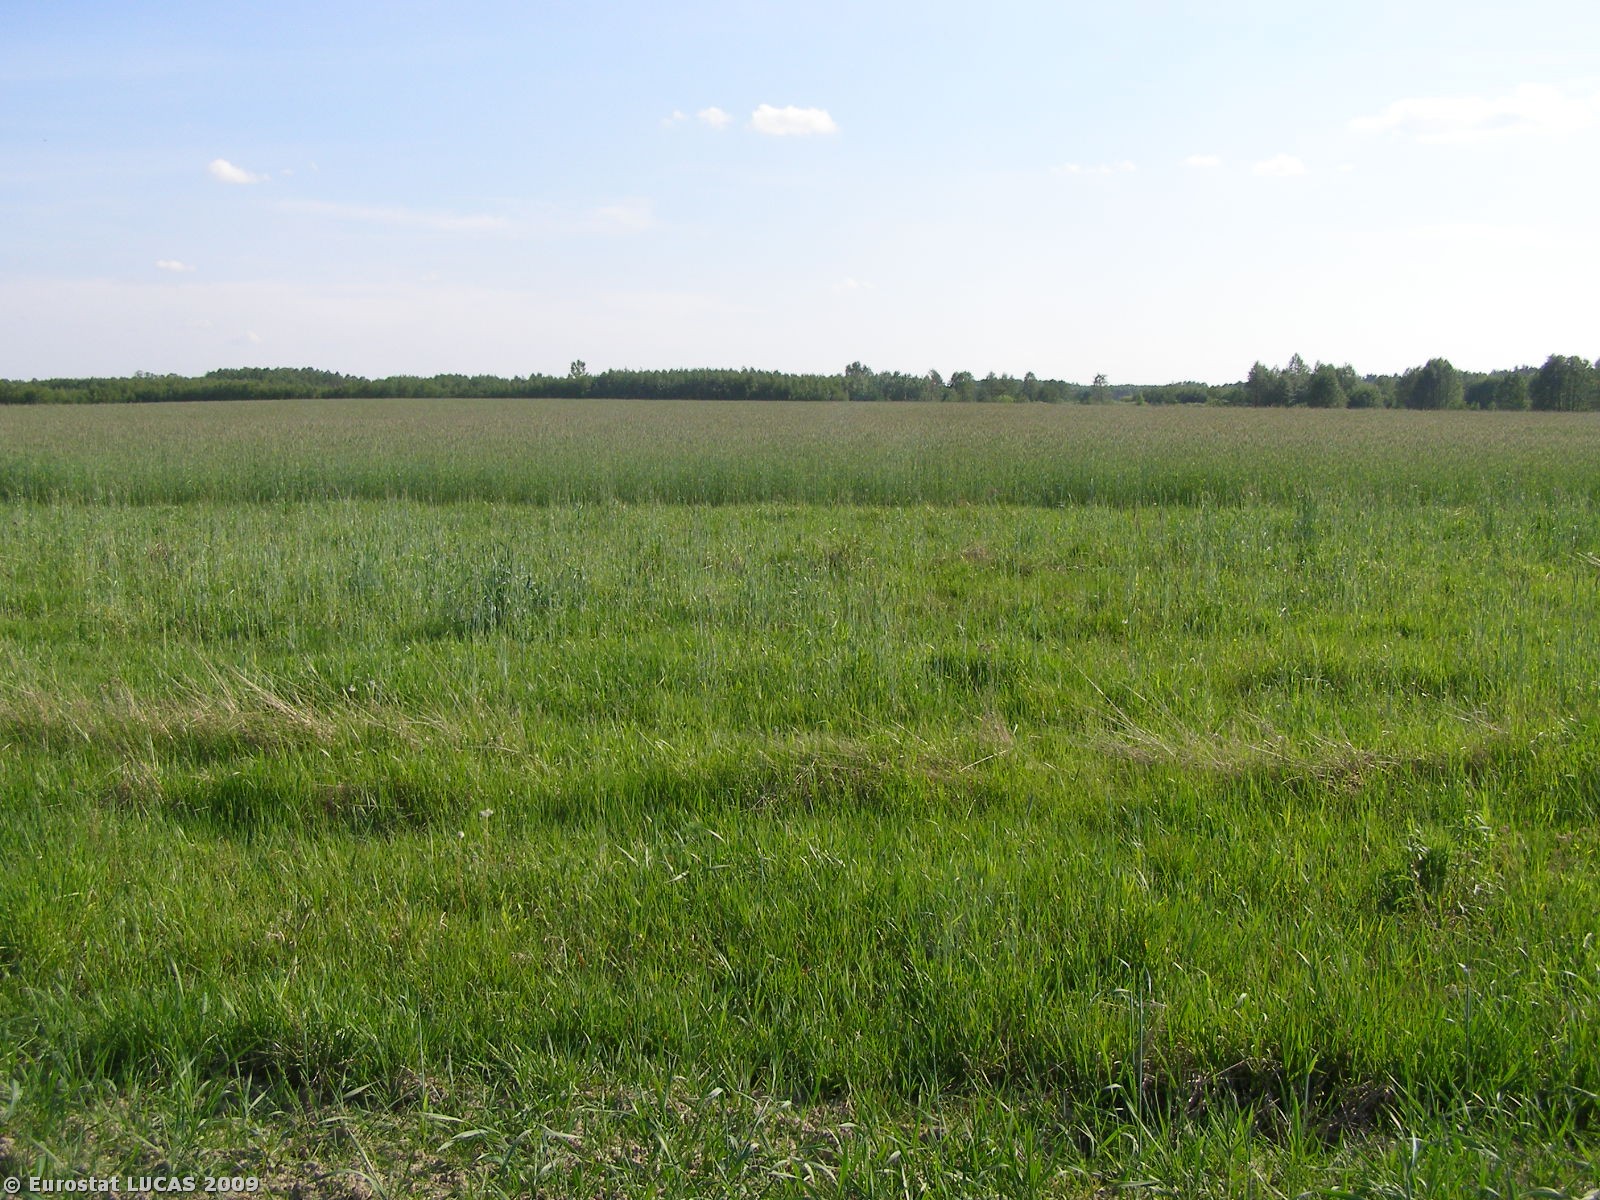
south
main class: Cropland
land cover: Rye
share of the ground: > 75 %
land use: Agriculture (excluding fallow land and kitchen gardens)
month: May
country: PL
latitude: 51.0871
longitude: 23.8393
